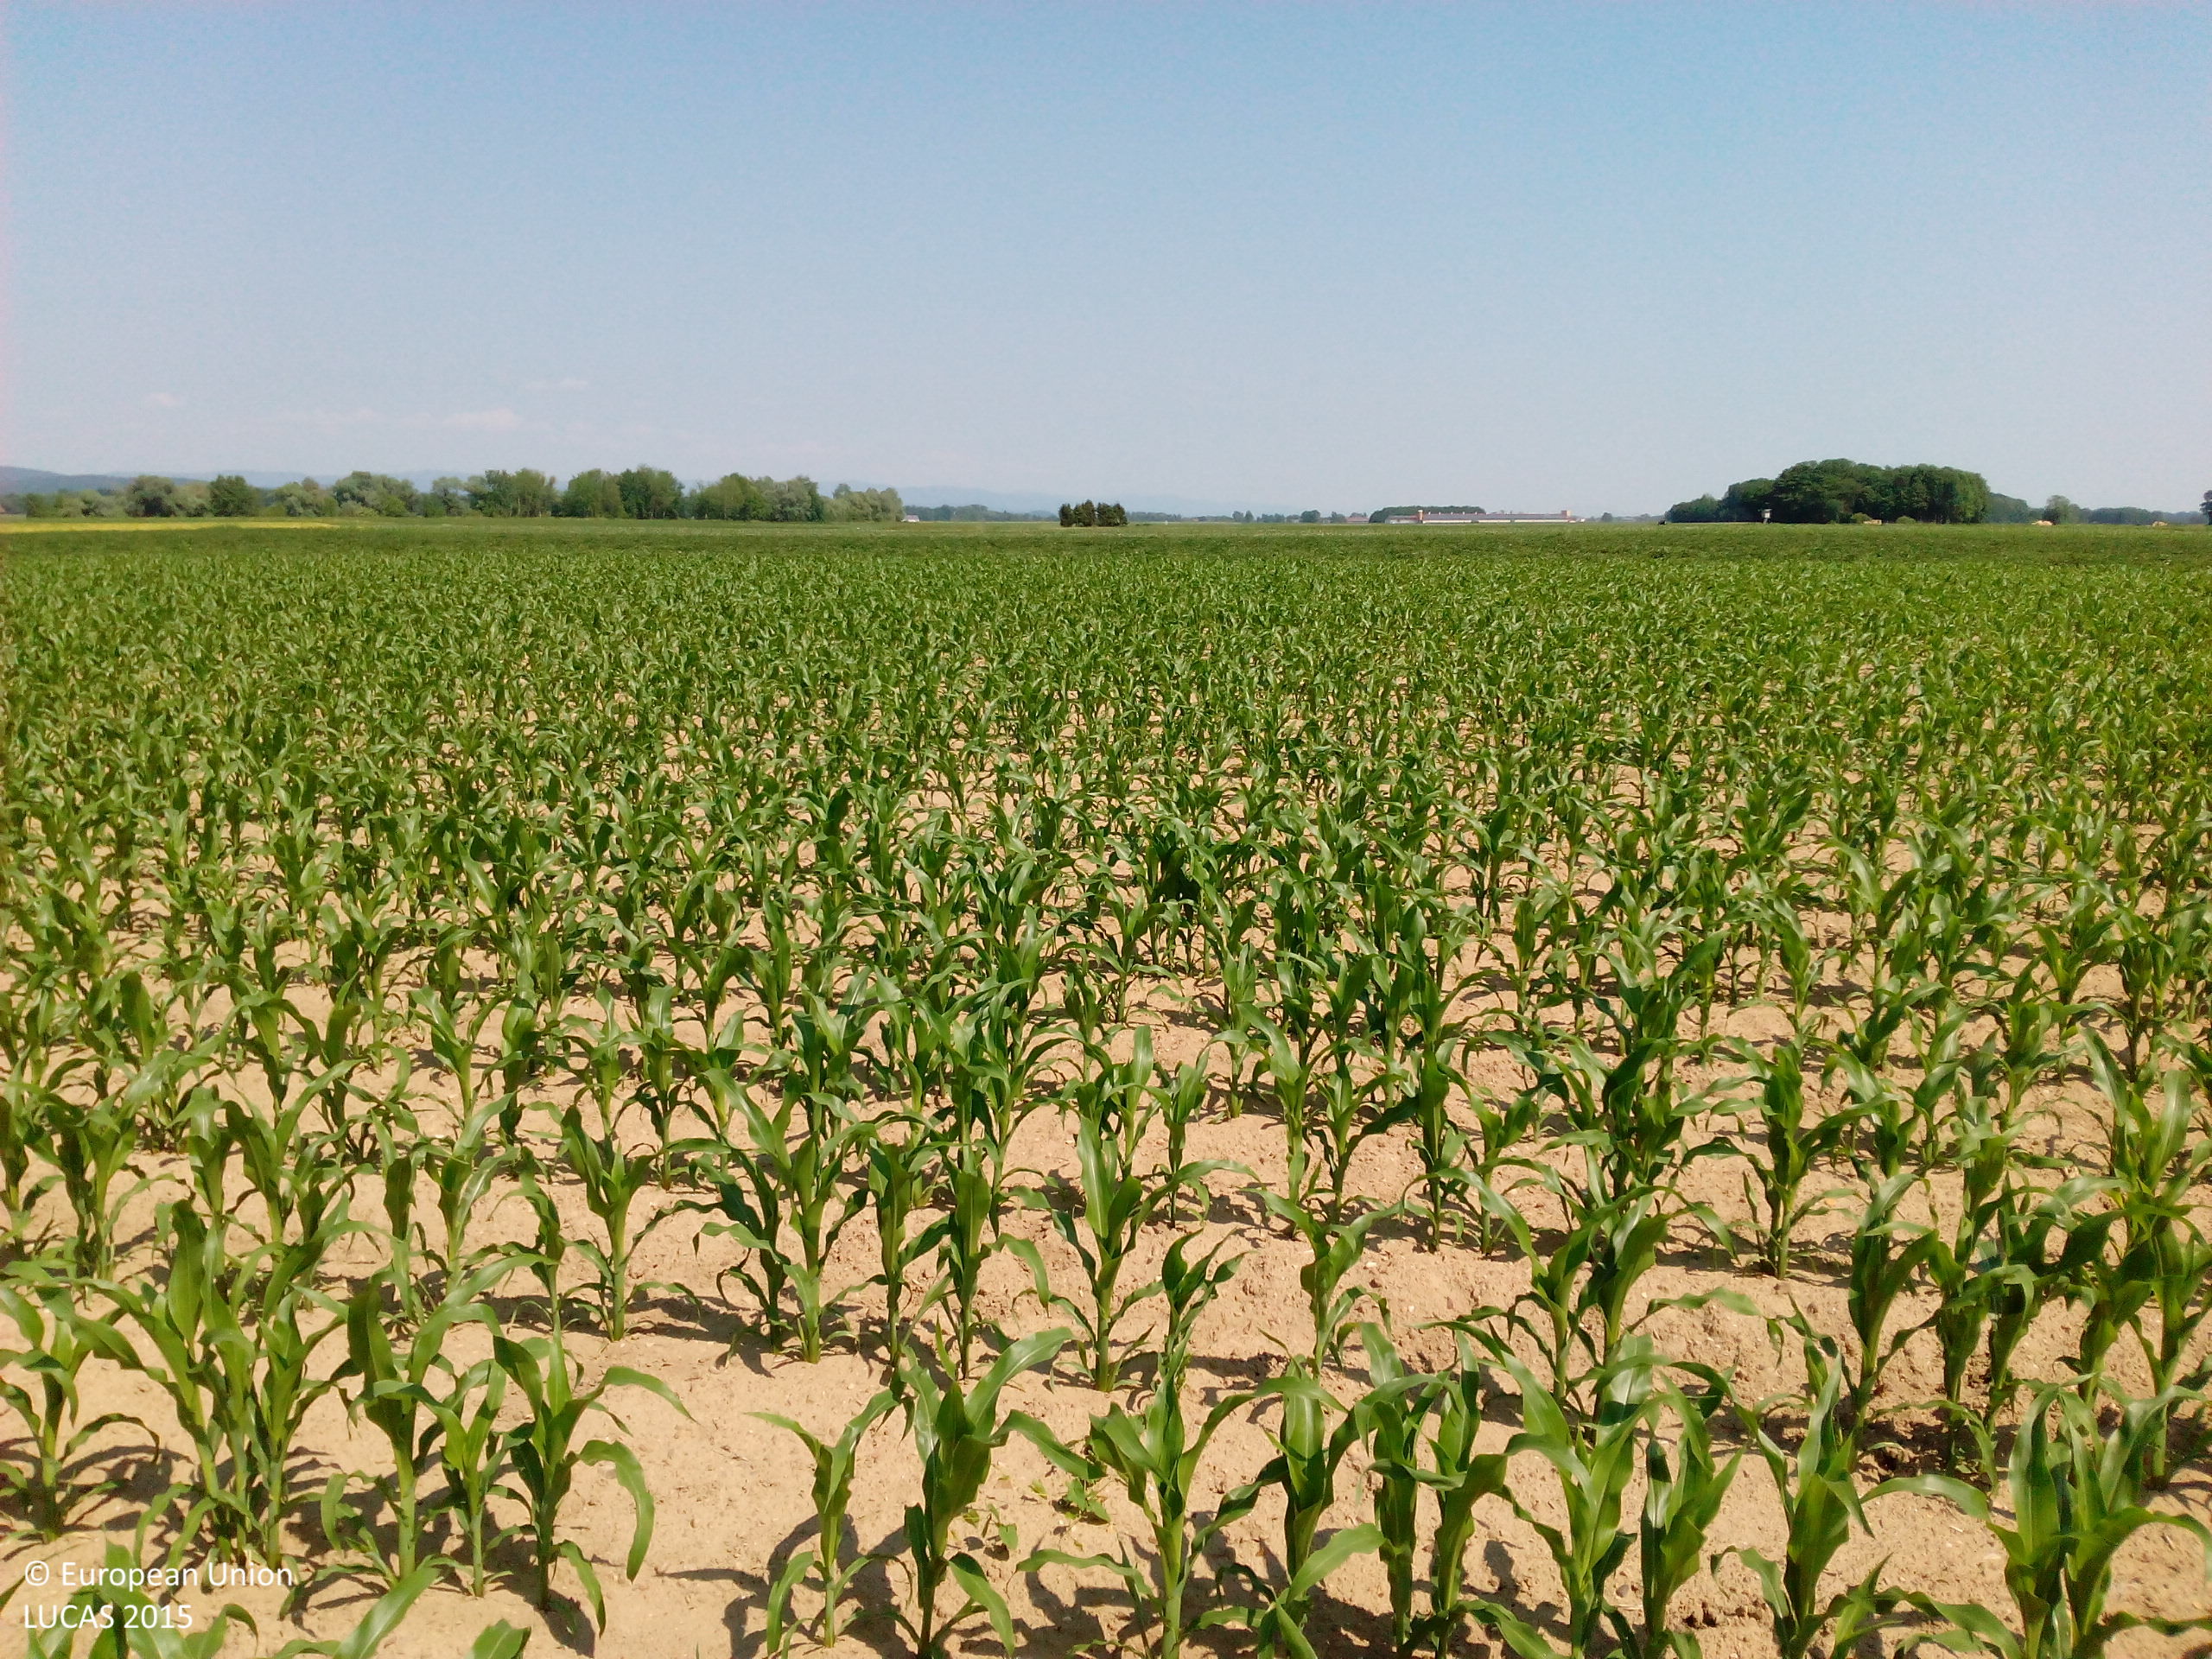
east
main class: Cropland
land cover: Maize
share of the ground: 10 - 25 %
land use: Agriculture (excluding fallow land and kitchen gardens)
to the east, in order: Maize; Potatoes; Maize; Potatoes
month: June
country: DE
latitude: 48.9531
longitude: 12.4165
